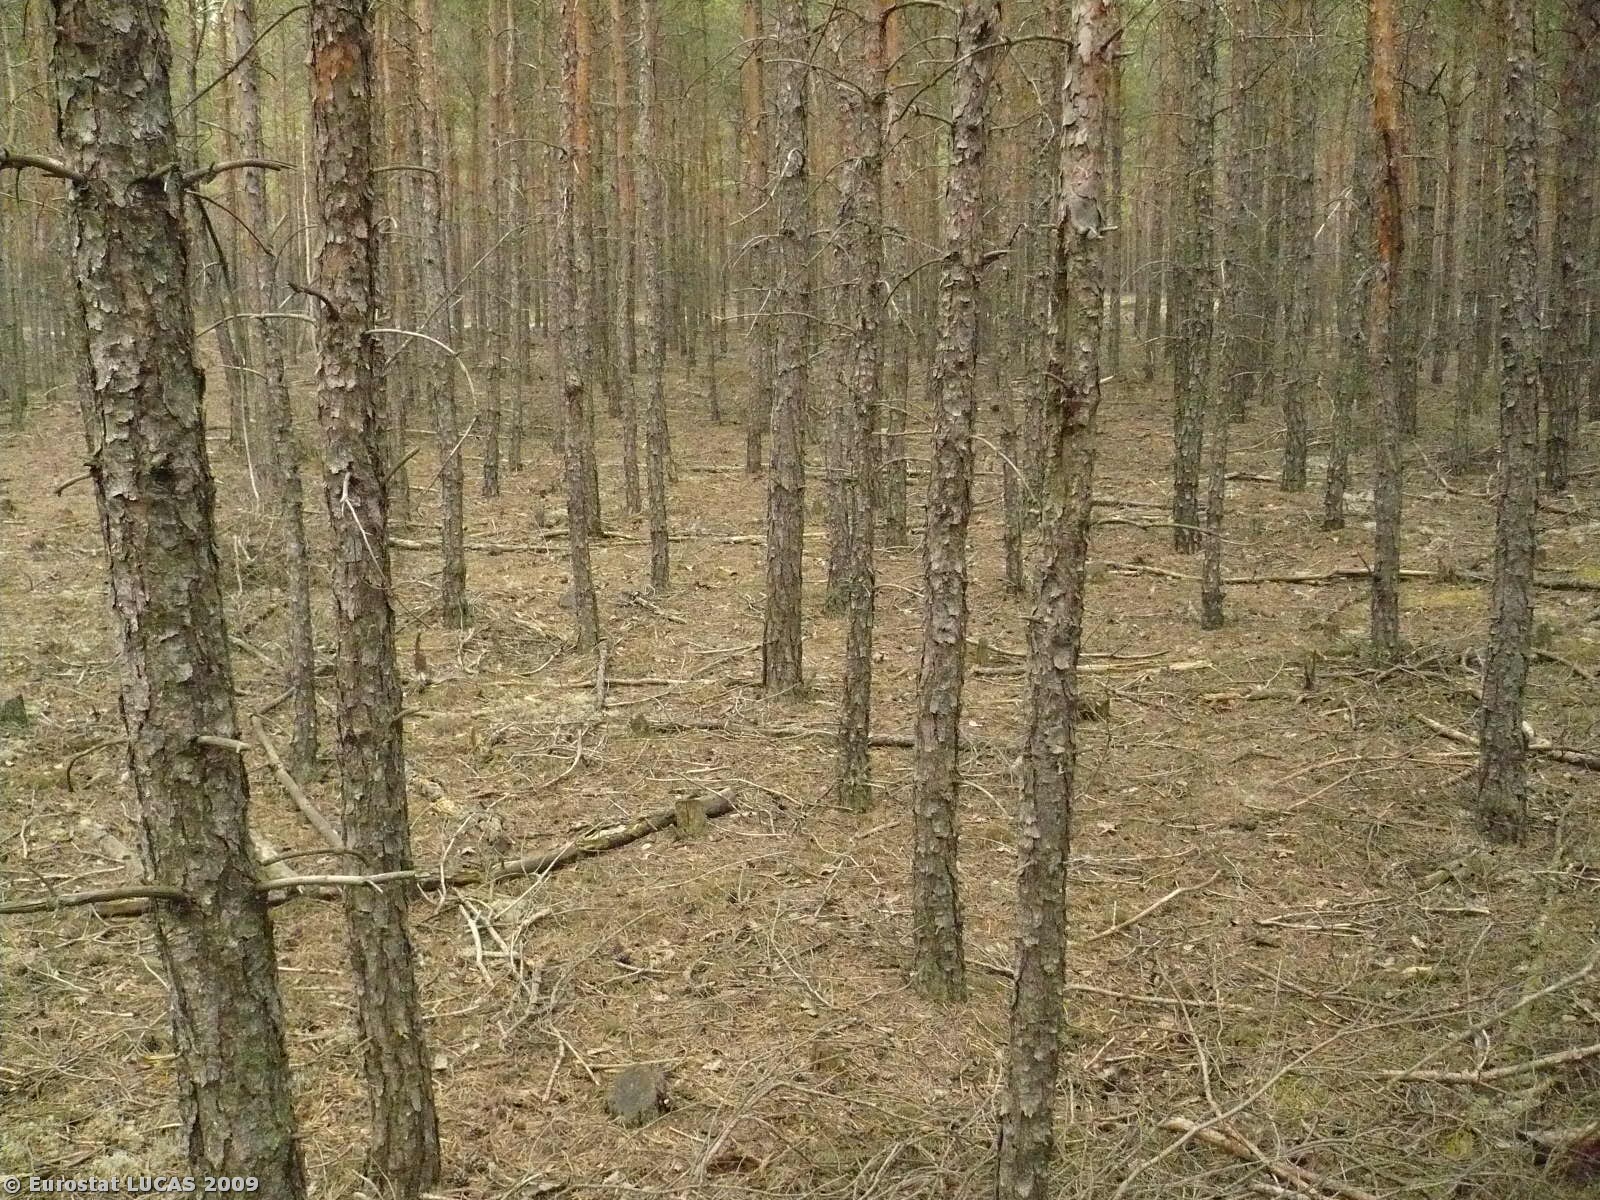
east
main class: Woodland
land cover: Coniferous woodland
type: hemiboreal forest and nemoral coniferous forest and mixed broadleaved-coniferous forest
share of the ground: > 75 %
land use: Forestry
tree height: > 5 m
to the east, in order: Coniferous woodland; Tracks; Coniferous woodland
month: May
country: PL
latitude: 51.9037
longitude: 15.1921
